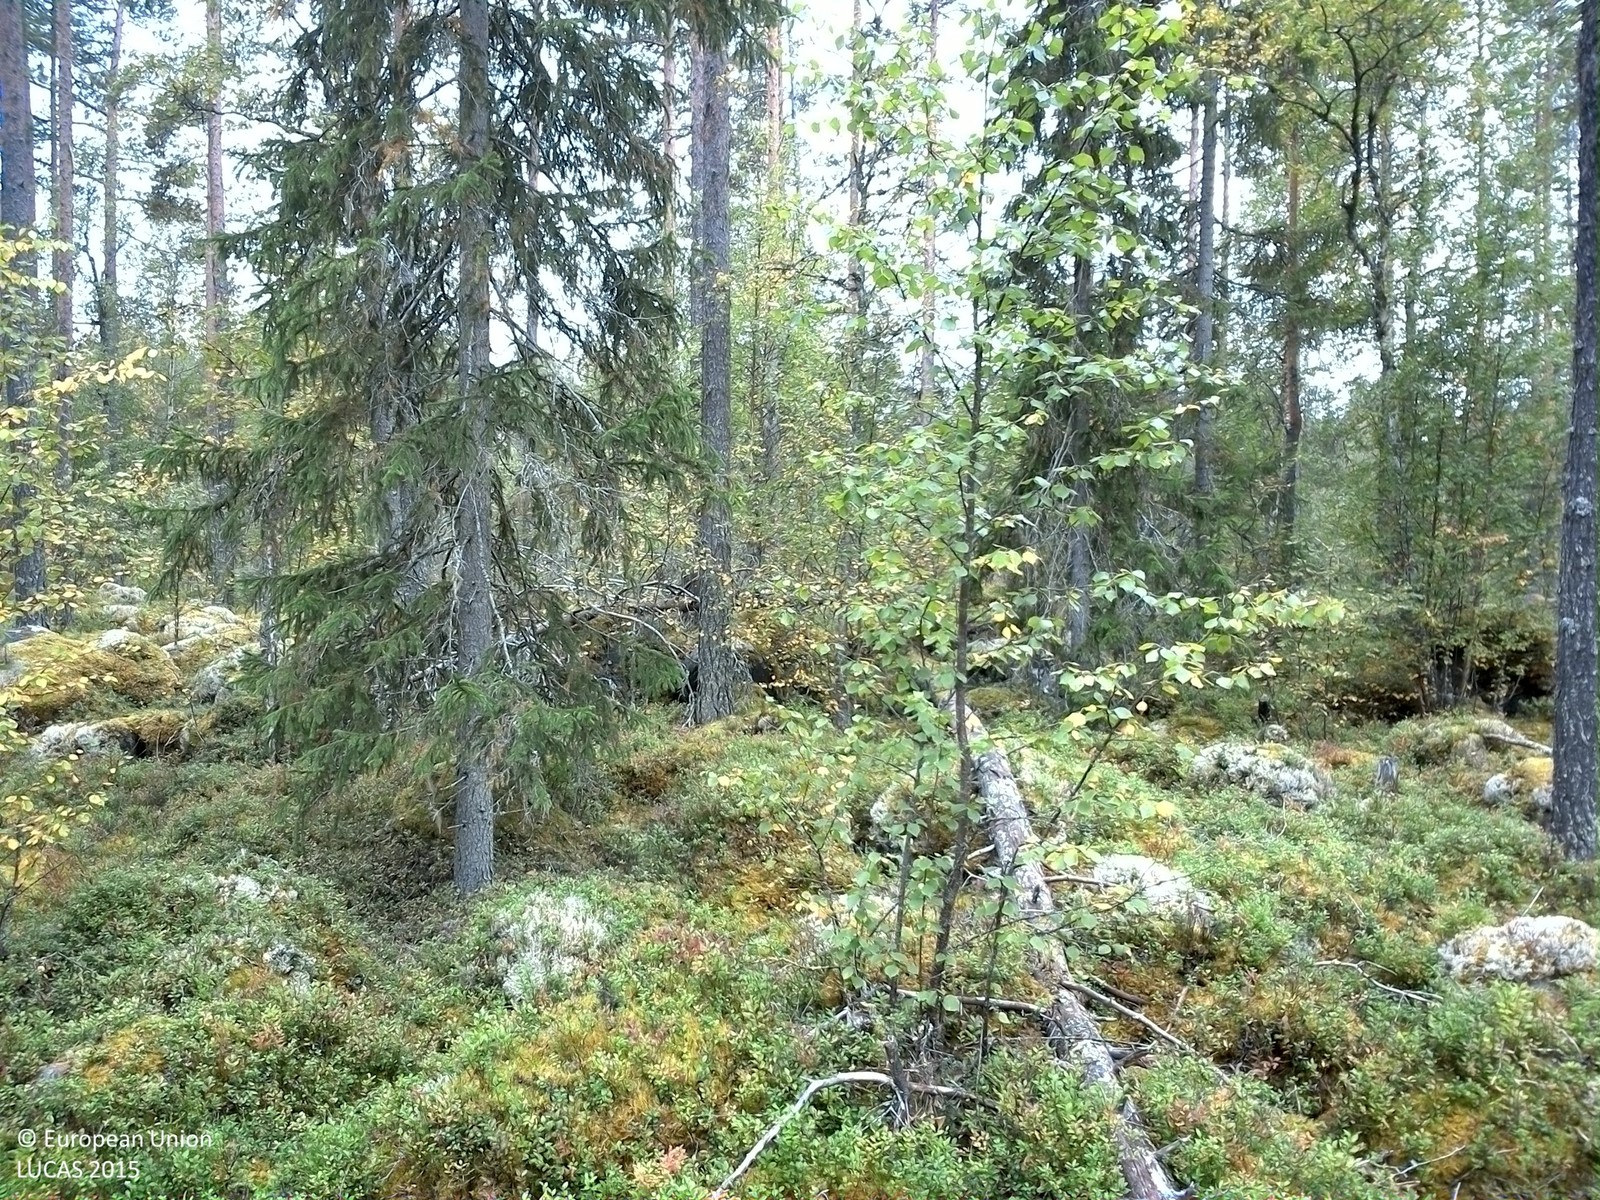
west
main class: Woodland
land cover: Pine dominated mixed woodland
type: boreal forest
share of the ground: 50 - 75 %
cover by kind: coniferous forest trees 40 %, shrubs 25 %, broadleaved forest trees 20 %, lichens and mosses 10 %, consolidated bare surface 5 %
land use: Forestry
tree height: > 5 m
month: September
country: SE
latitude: 61.6602
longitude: 15.0635
